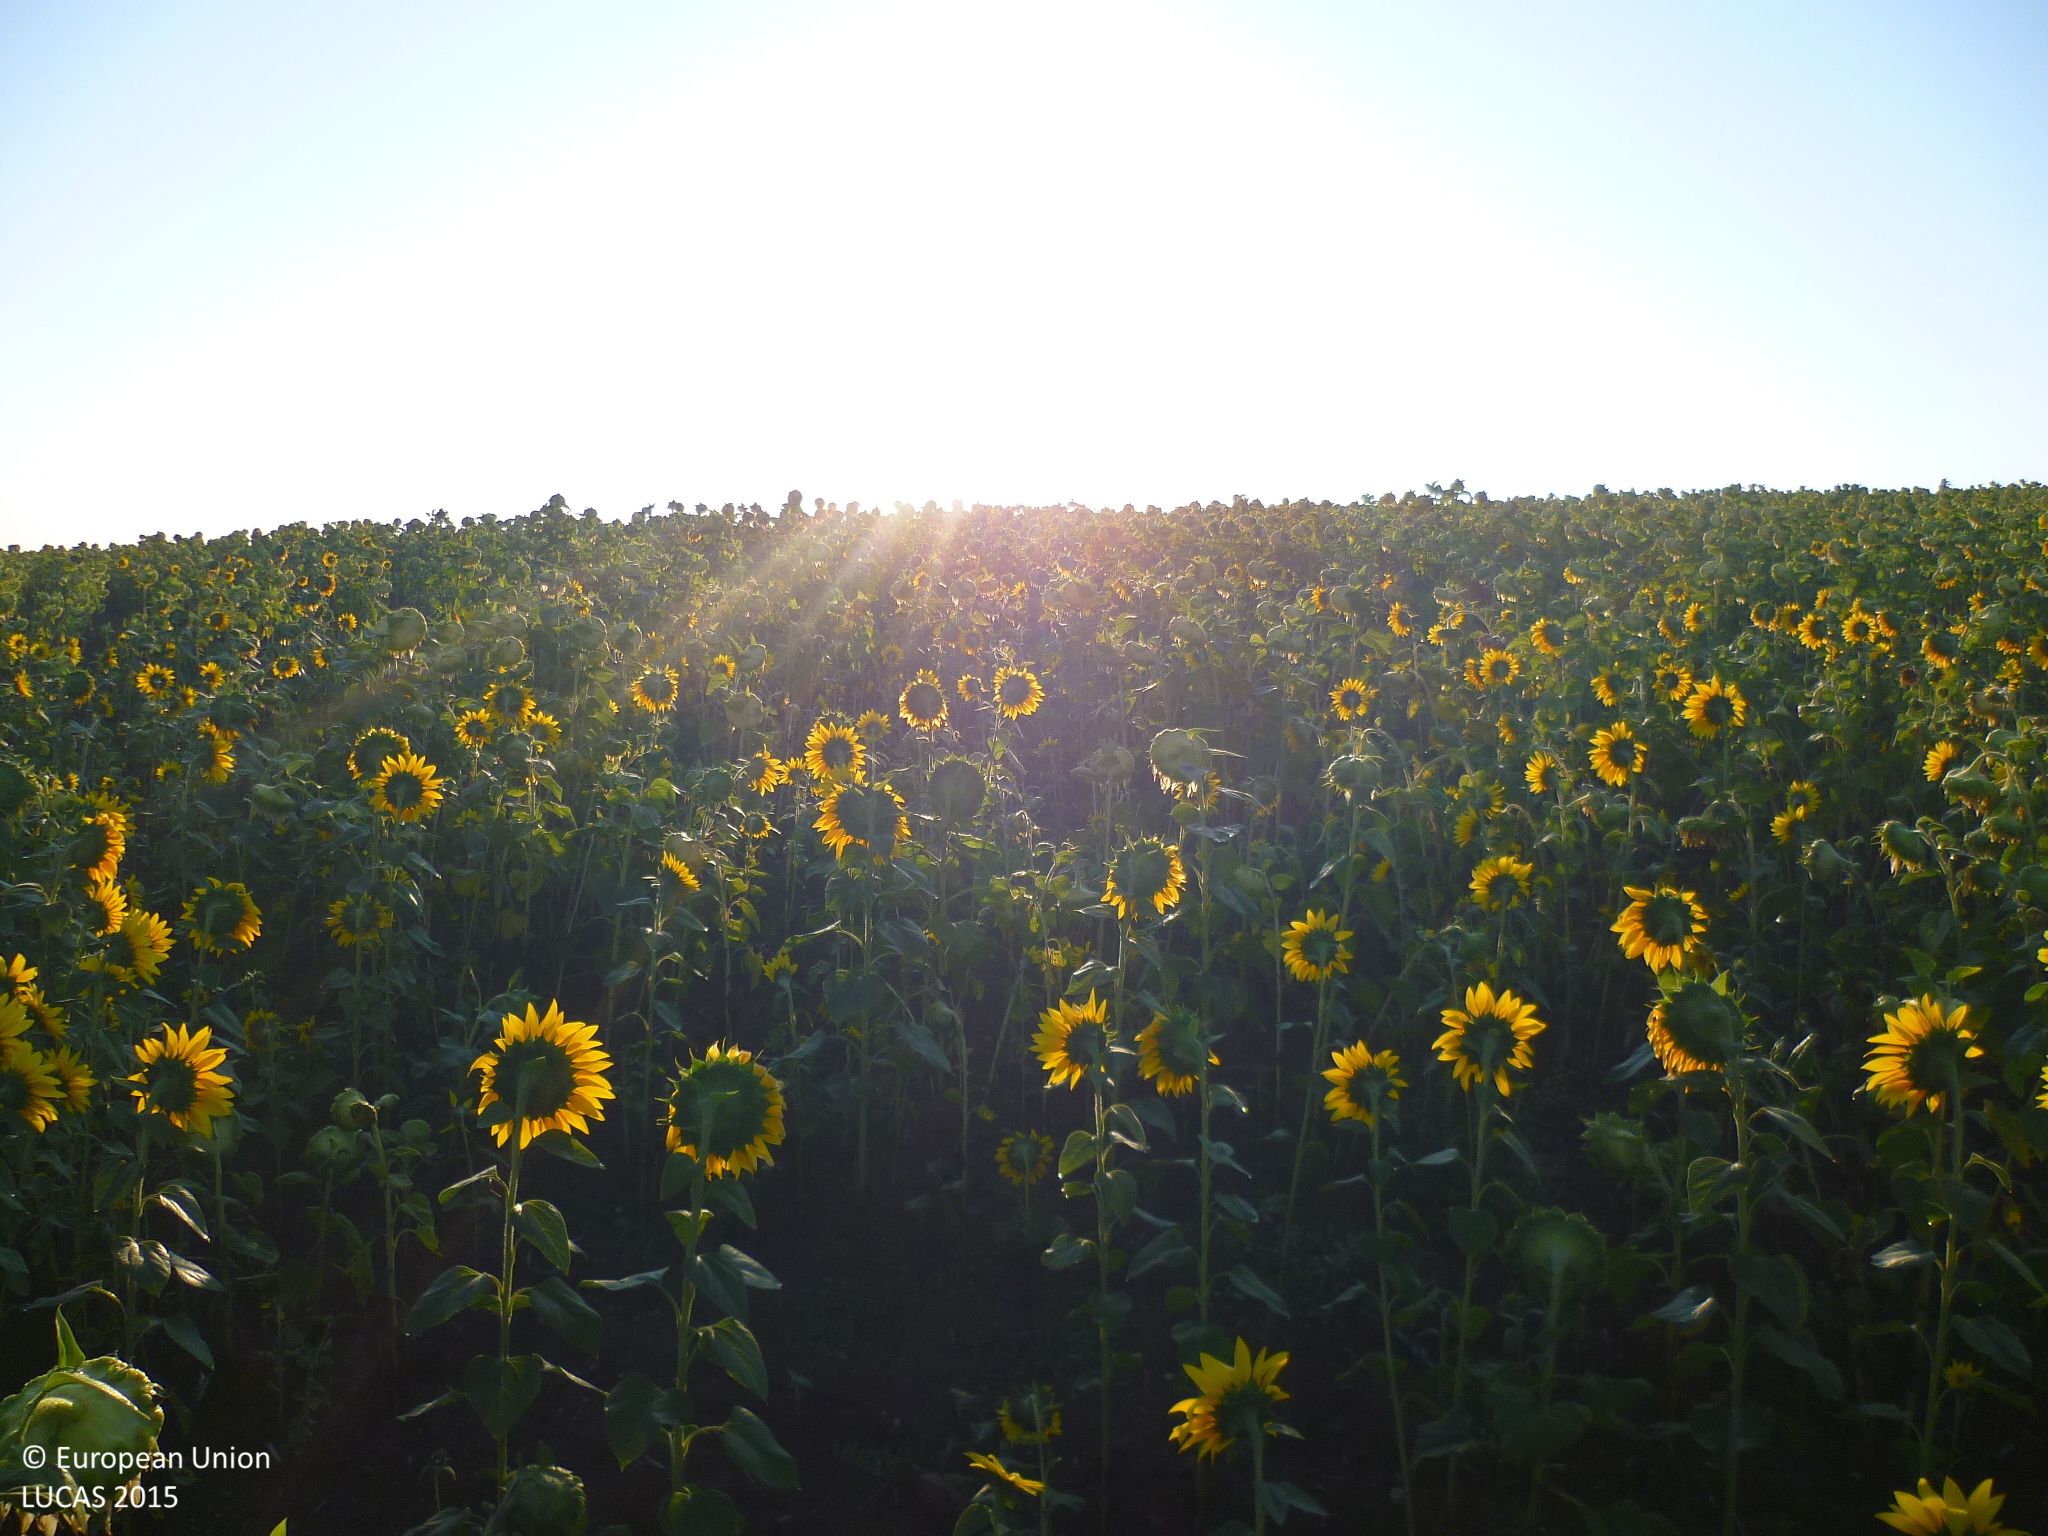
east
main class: Cropland
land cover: Sunflower
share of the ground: > 75 %
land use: Agriculture (excluding fallow land and kitchen gardens)
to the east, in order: Sunflower
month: September
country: BG
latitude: 42.6875
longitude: 23.1522
